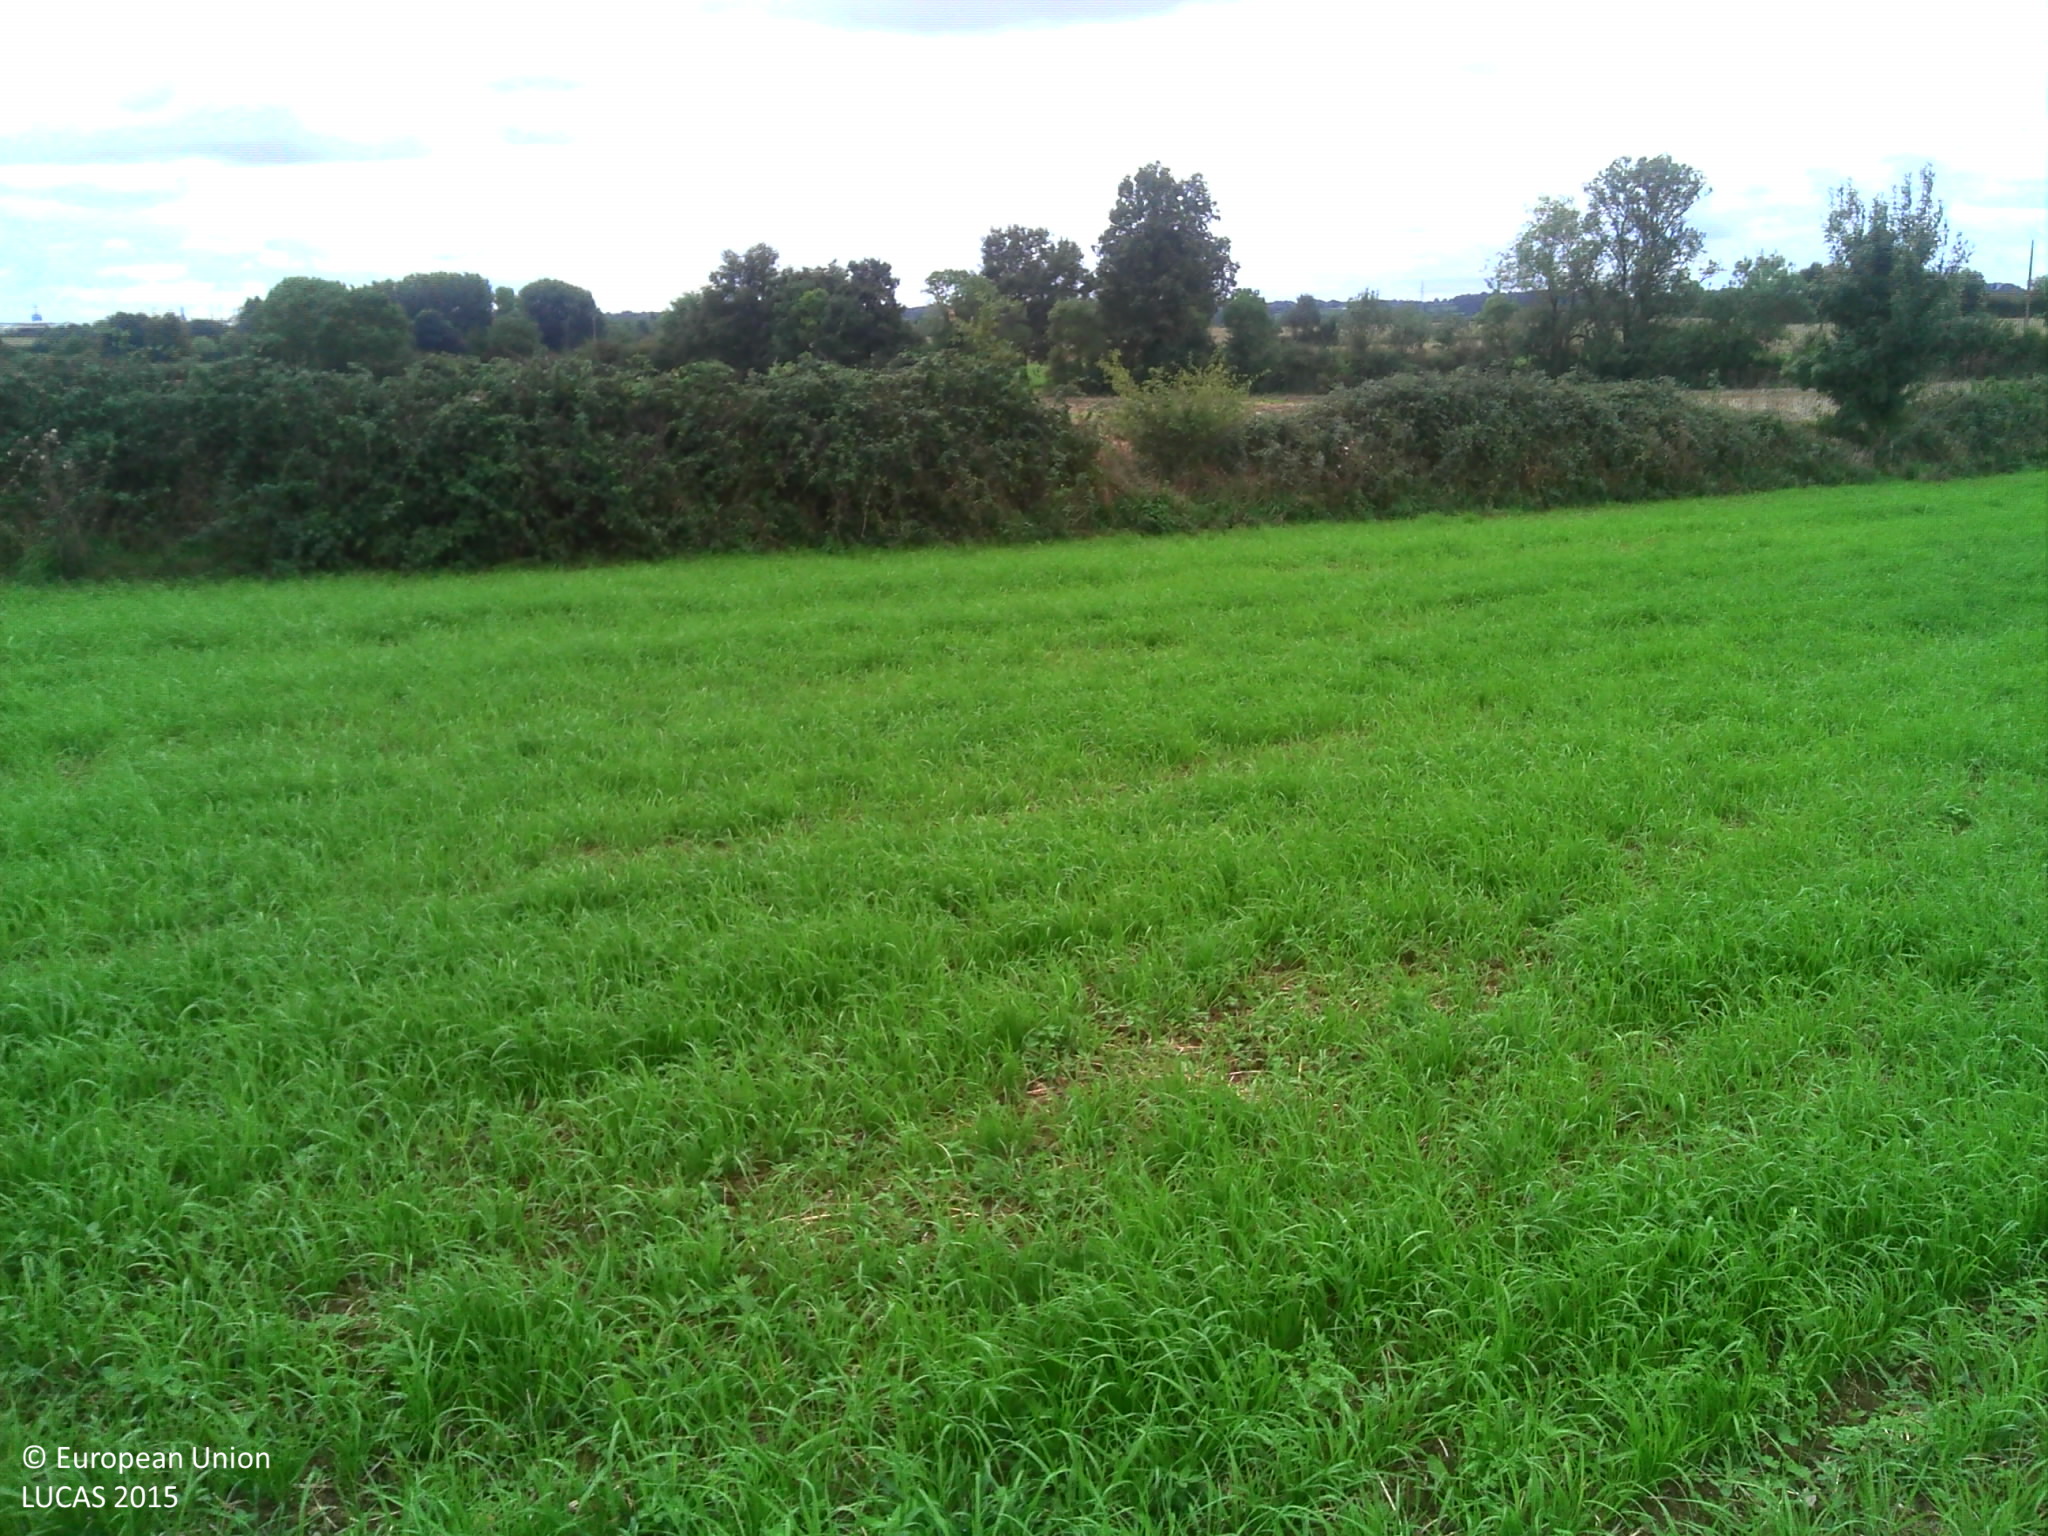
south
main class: Cropland
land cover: Temporary grasslands
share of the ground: > 75 %
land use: Agriculture (excluding fallow land and kitchen gardens)
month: September
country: FR
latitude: 46.7204
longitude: -1.0628
